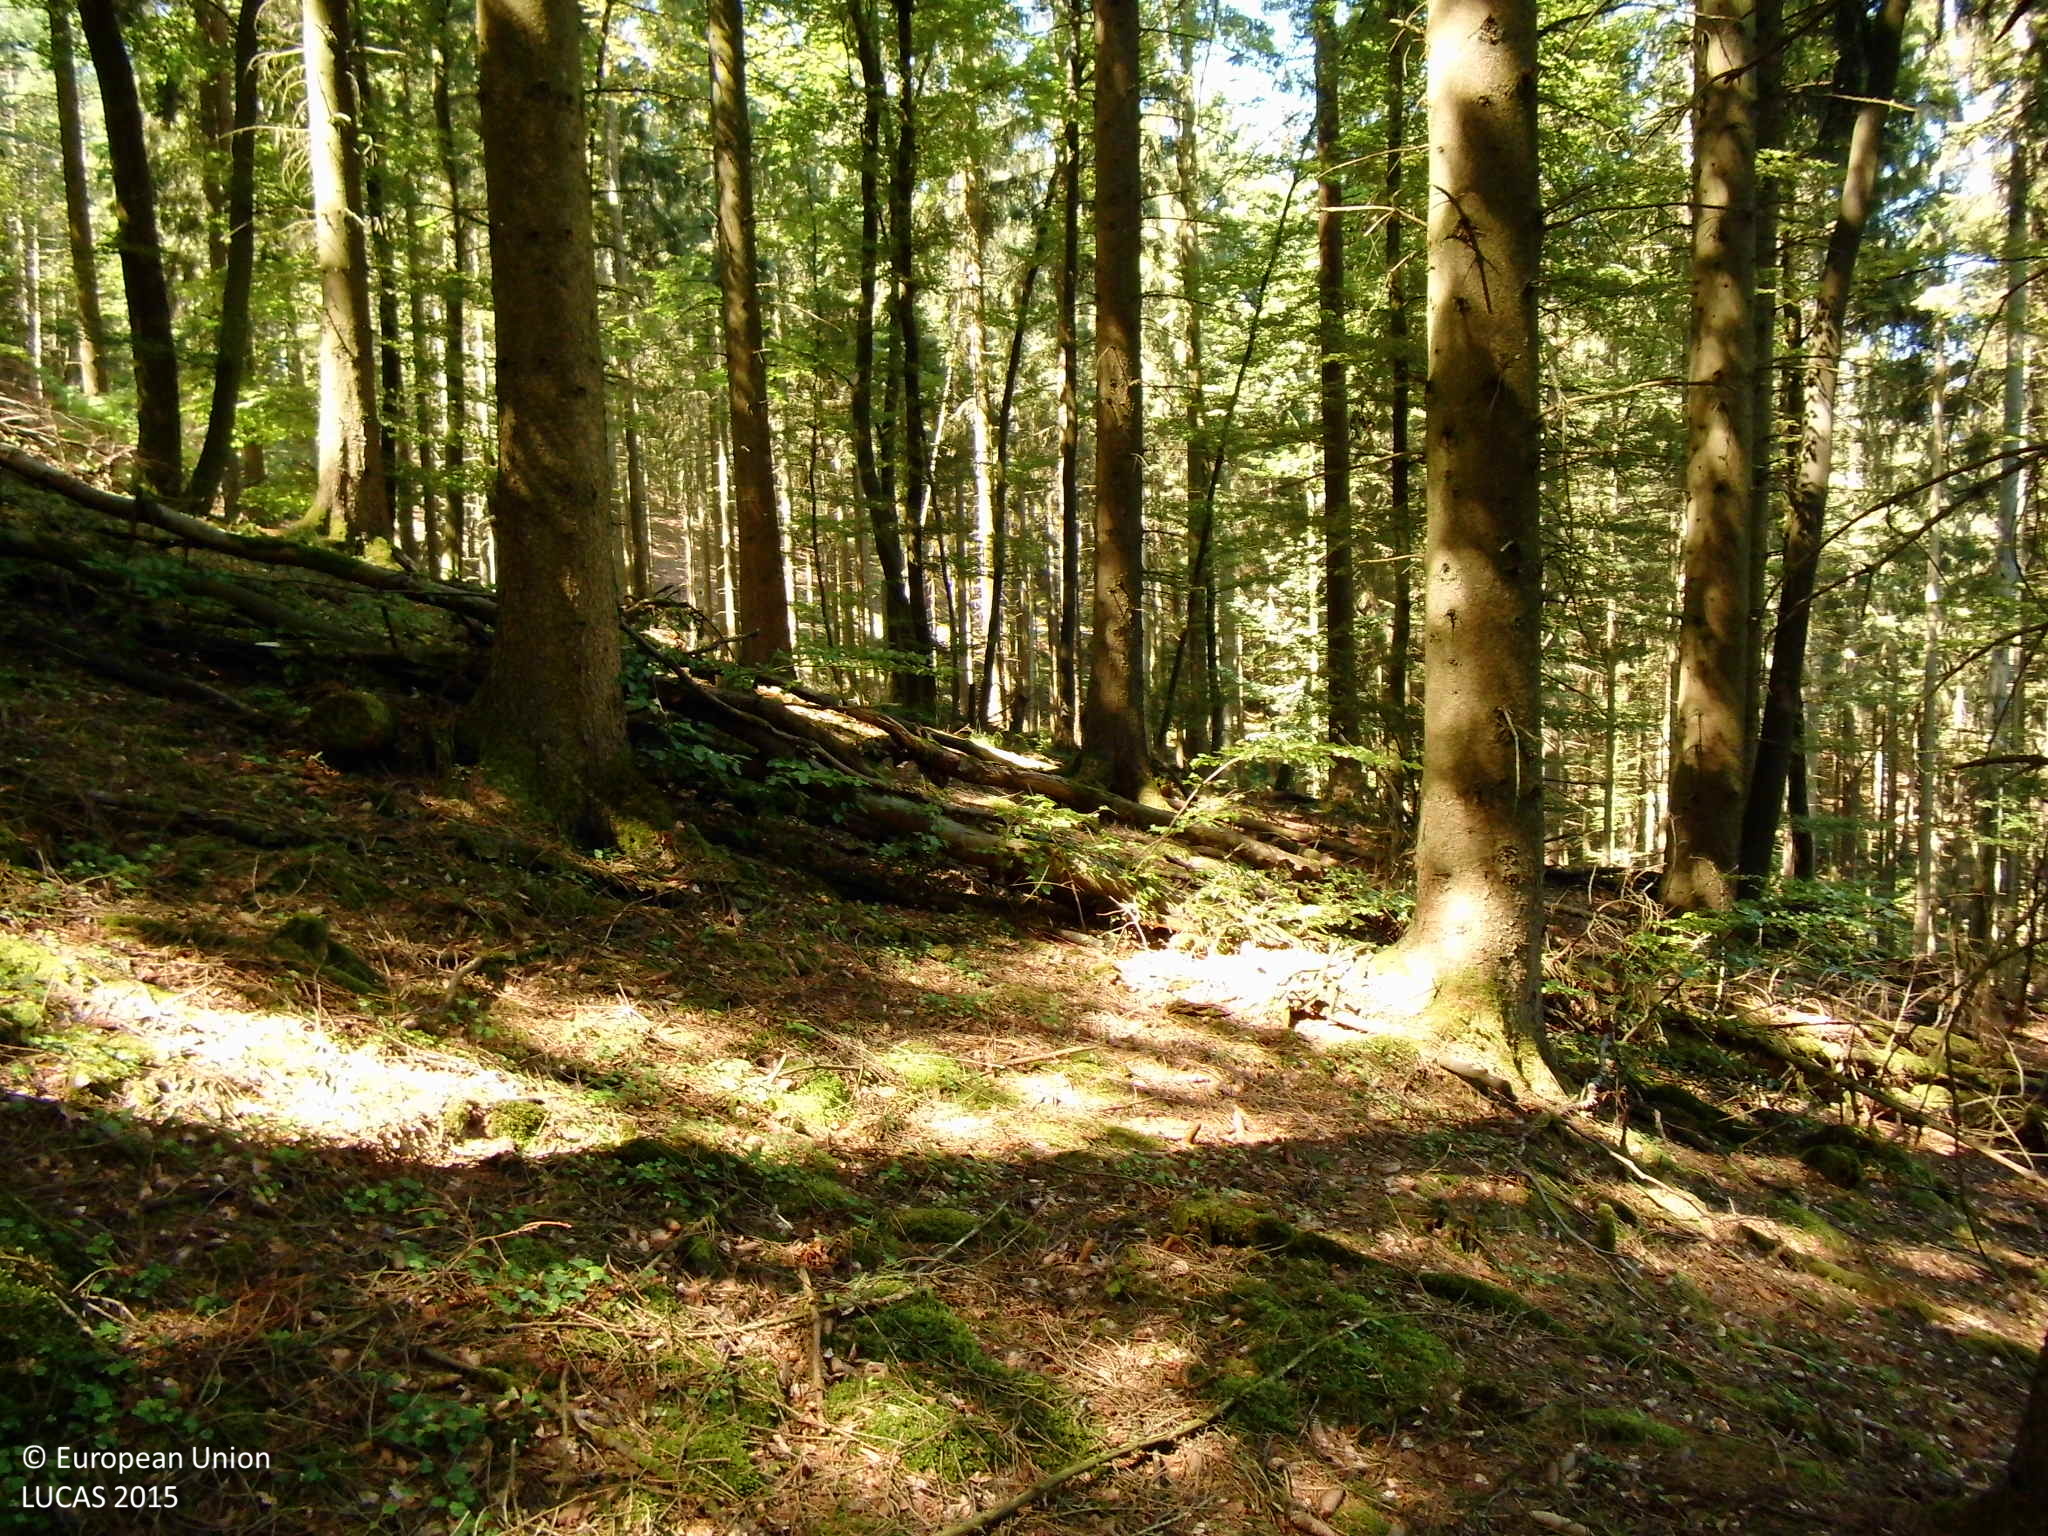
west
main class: Woodland
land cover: Spruce dominated mixed woodland
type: hemiboreal forest and nemoral coniferous forest and mixed broadleaved-coniferous forest
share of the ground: > 75 %
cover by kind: coniferous forest trees 60 %, broadleaved forest trees 25 %, herbaceous plants 5 %, lichens and mosses 5 %, unconsolidated bare surface 5 %
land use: Forestry
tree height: > 5 m
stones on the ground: < 10 %
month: August
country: DE
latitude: 51.1022
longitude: 8.0153
